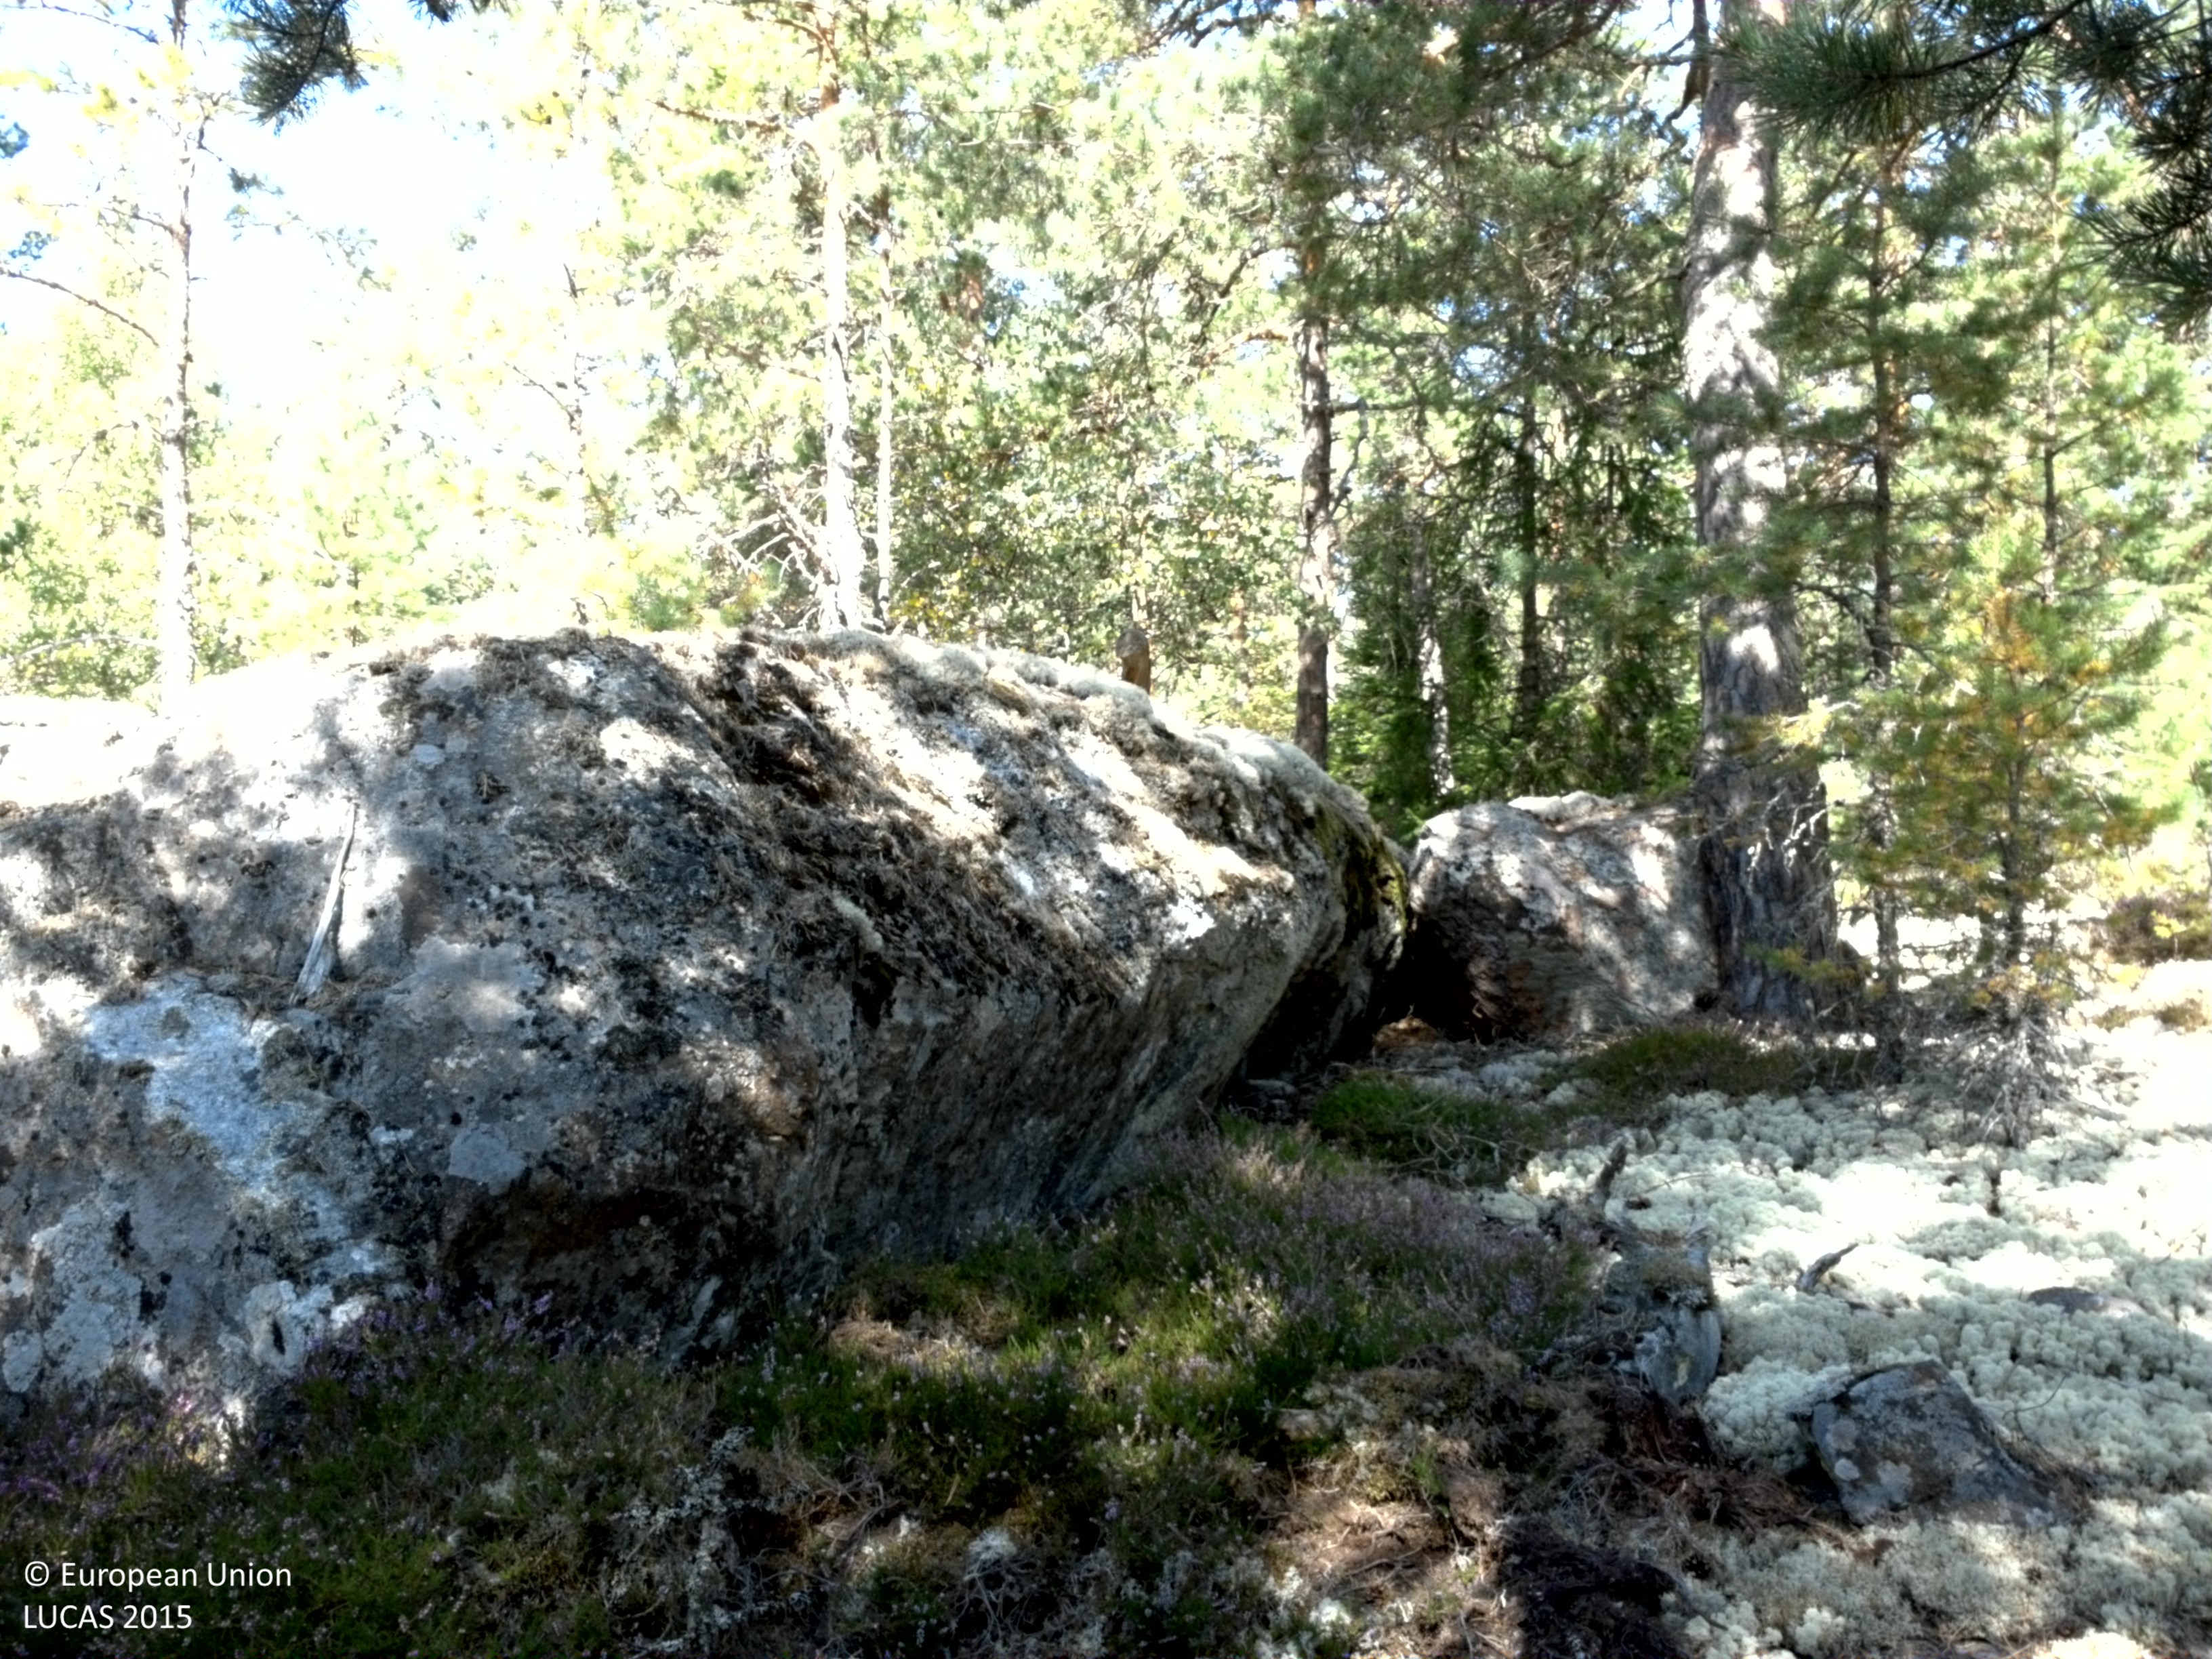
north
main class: Woodland
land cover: Pine dominated coniferous woodland
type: boreal forest
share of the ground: > 75 %
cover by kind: coniferous forest trees 60 %, lichens and mosses 25 %, shrubs 10 %, broadleaved forest trees 5 %
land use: Amenities, museums, leisure
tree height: > 5 m
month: August
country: SE
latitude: 59.4452
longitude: 17.7033
